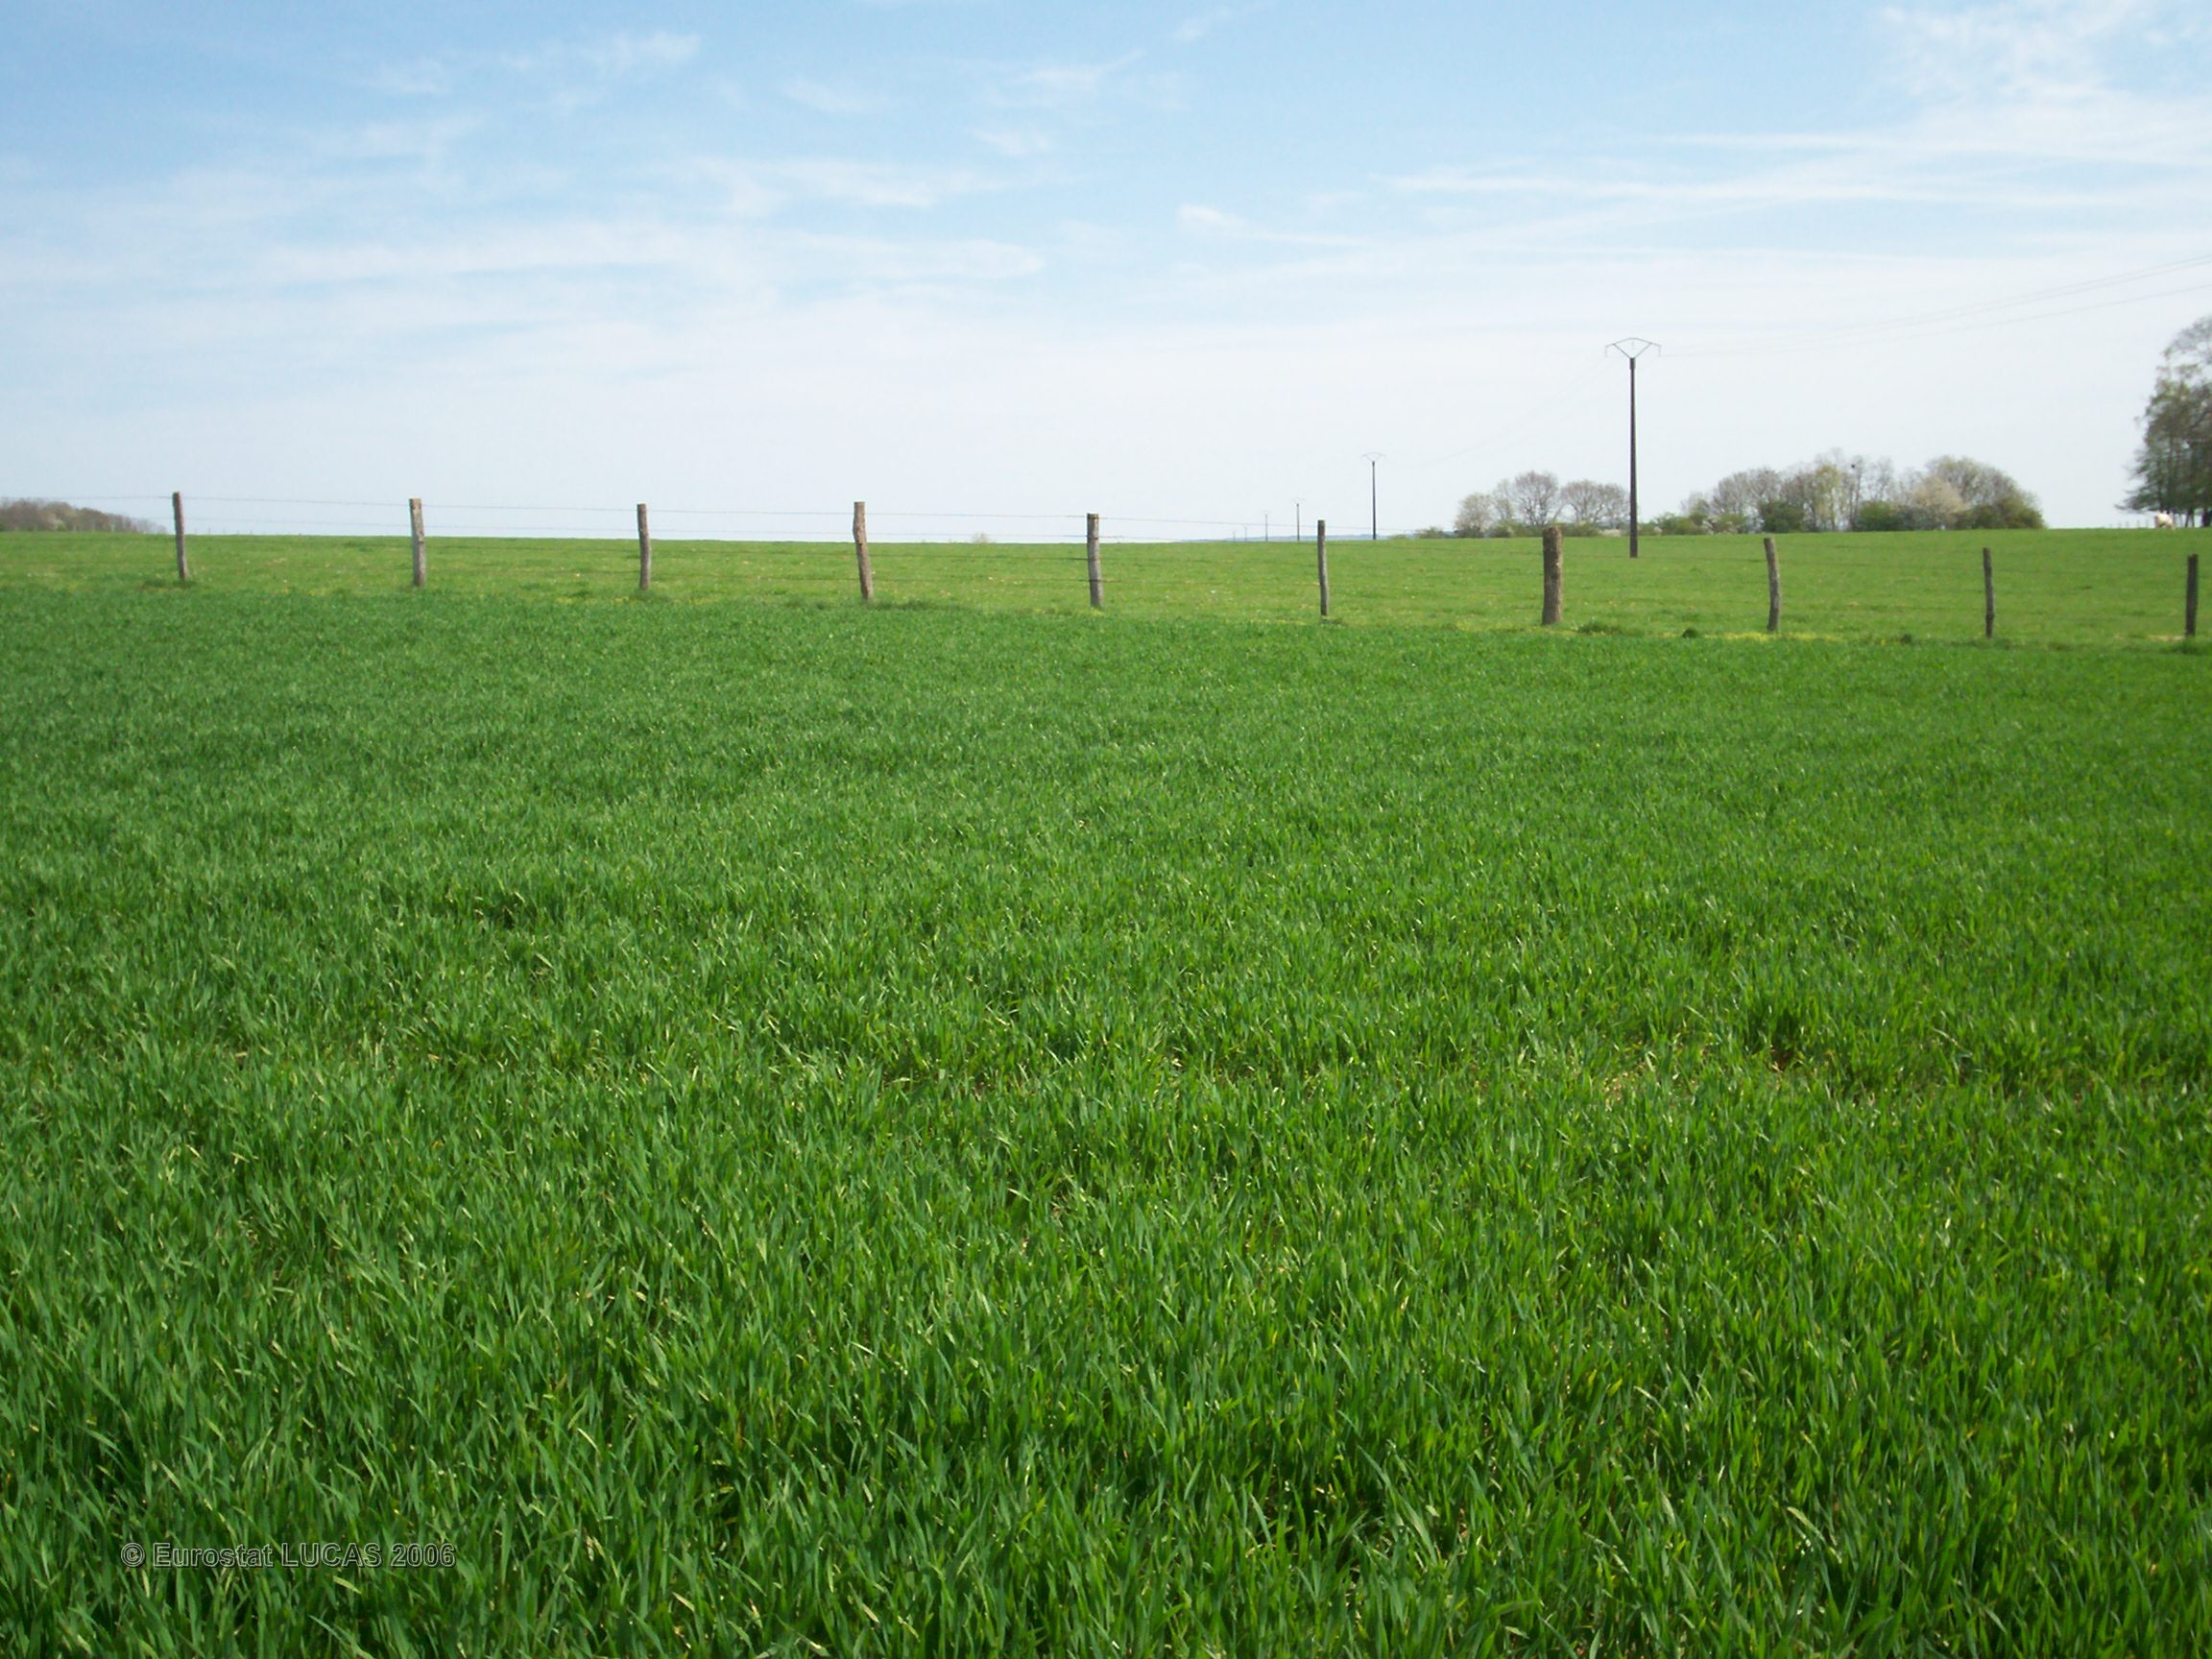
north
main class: Cropland
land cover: Common wheat
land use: Agriculture (excluding fallow land and kitchen gardens)
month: April
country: FR
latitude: 47.9338
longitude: 5.9716
